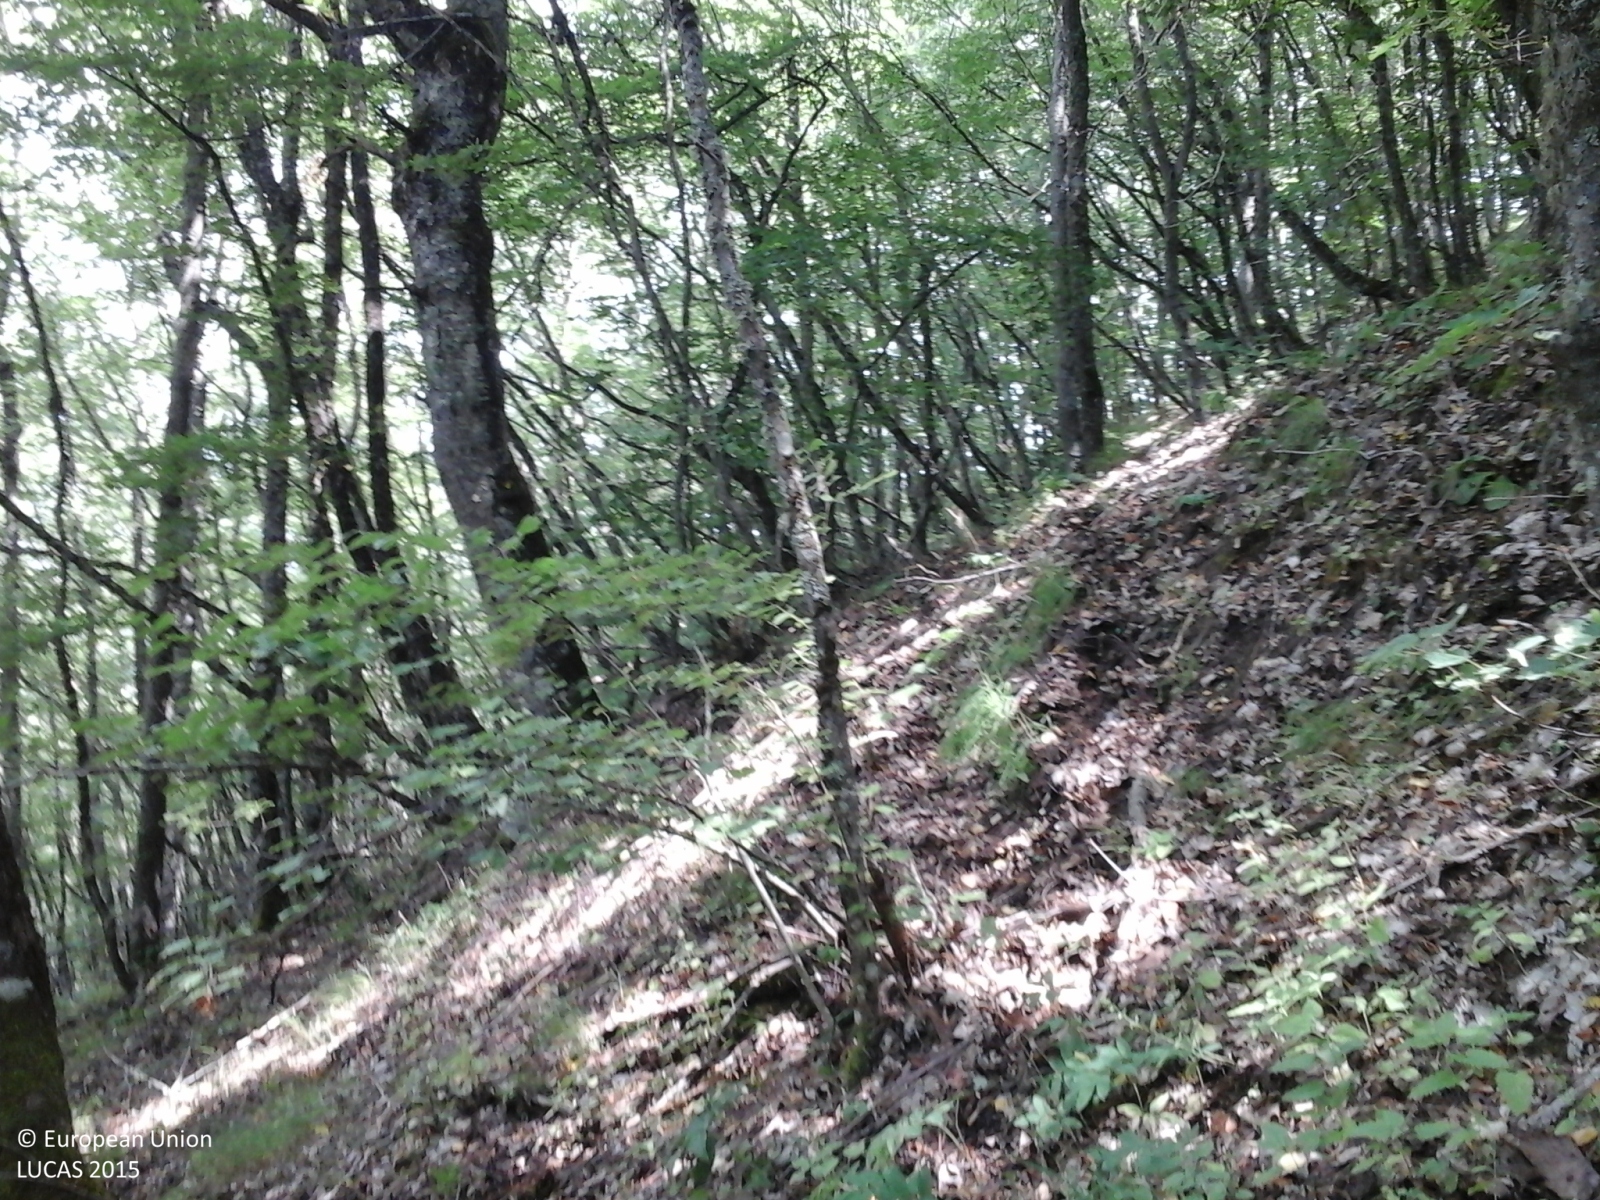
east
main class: Woodland
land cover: Broadleaved woodland
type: beech forest
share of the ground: > 75 %
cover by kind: broadleaved forest trees 85 %, herbaceous plants 15 %
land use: Forestry
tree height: > 5 m
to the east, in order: Broadleaved woodland
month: August
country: GR
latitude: 40.3892
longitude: 21.0489
